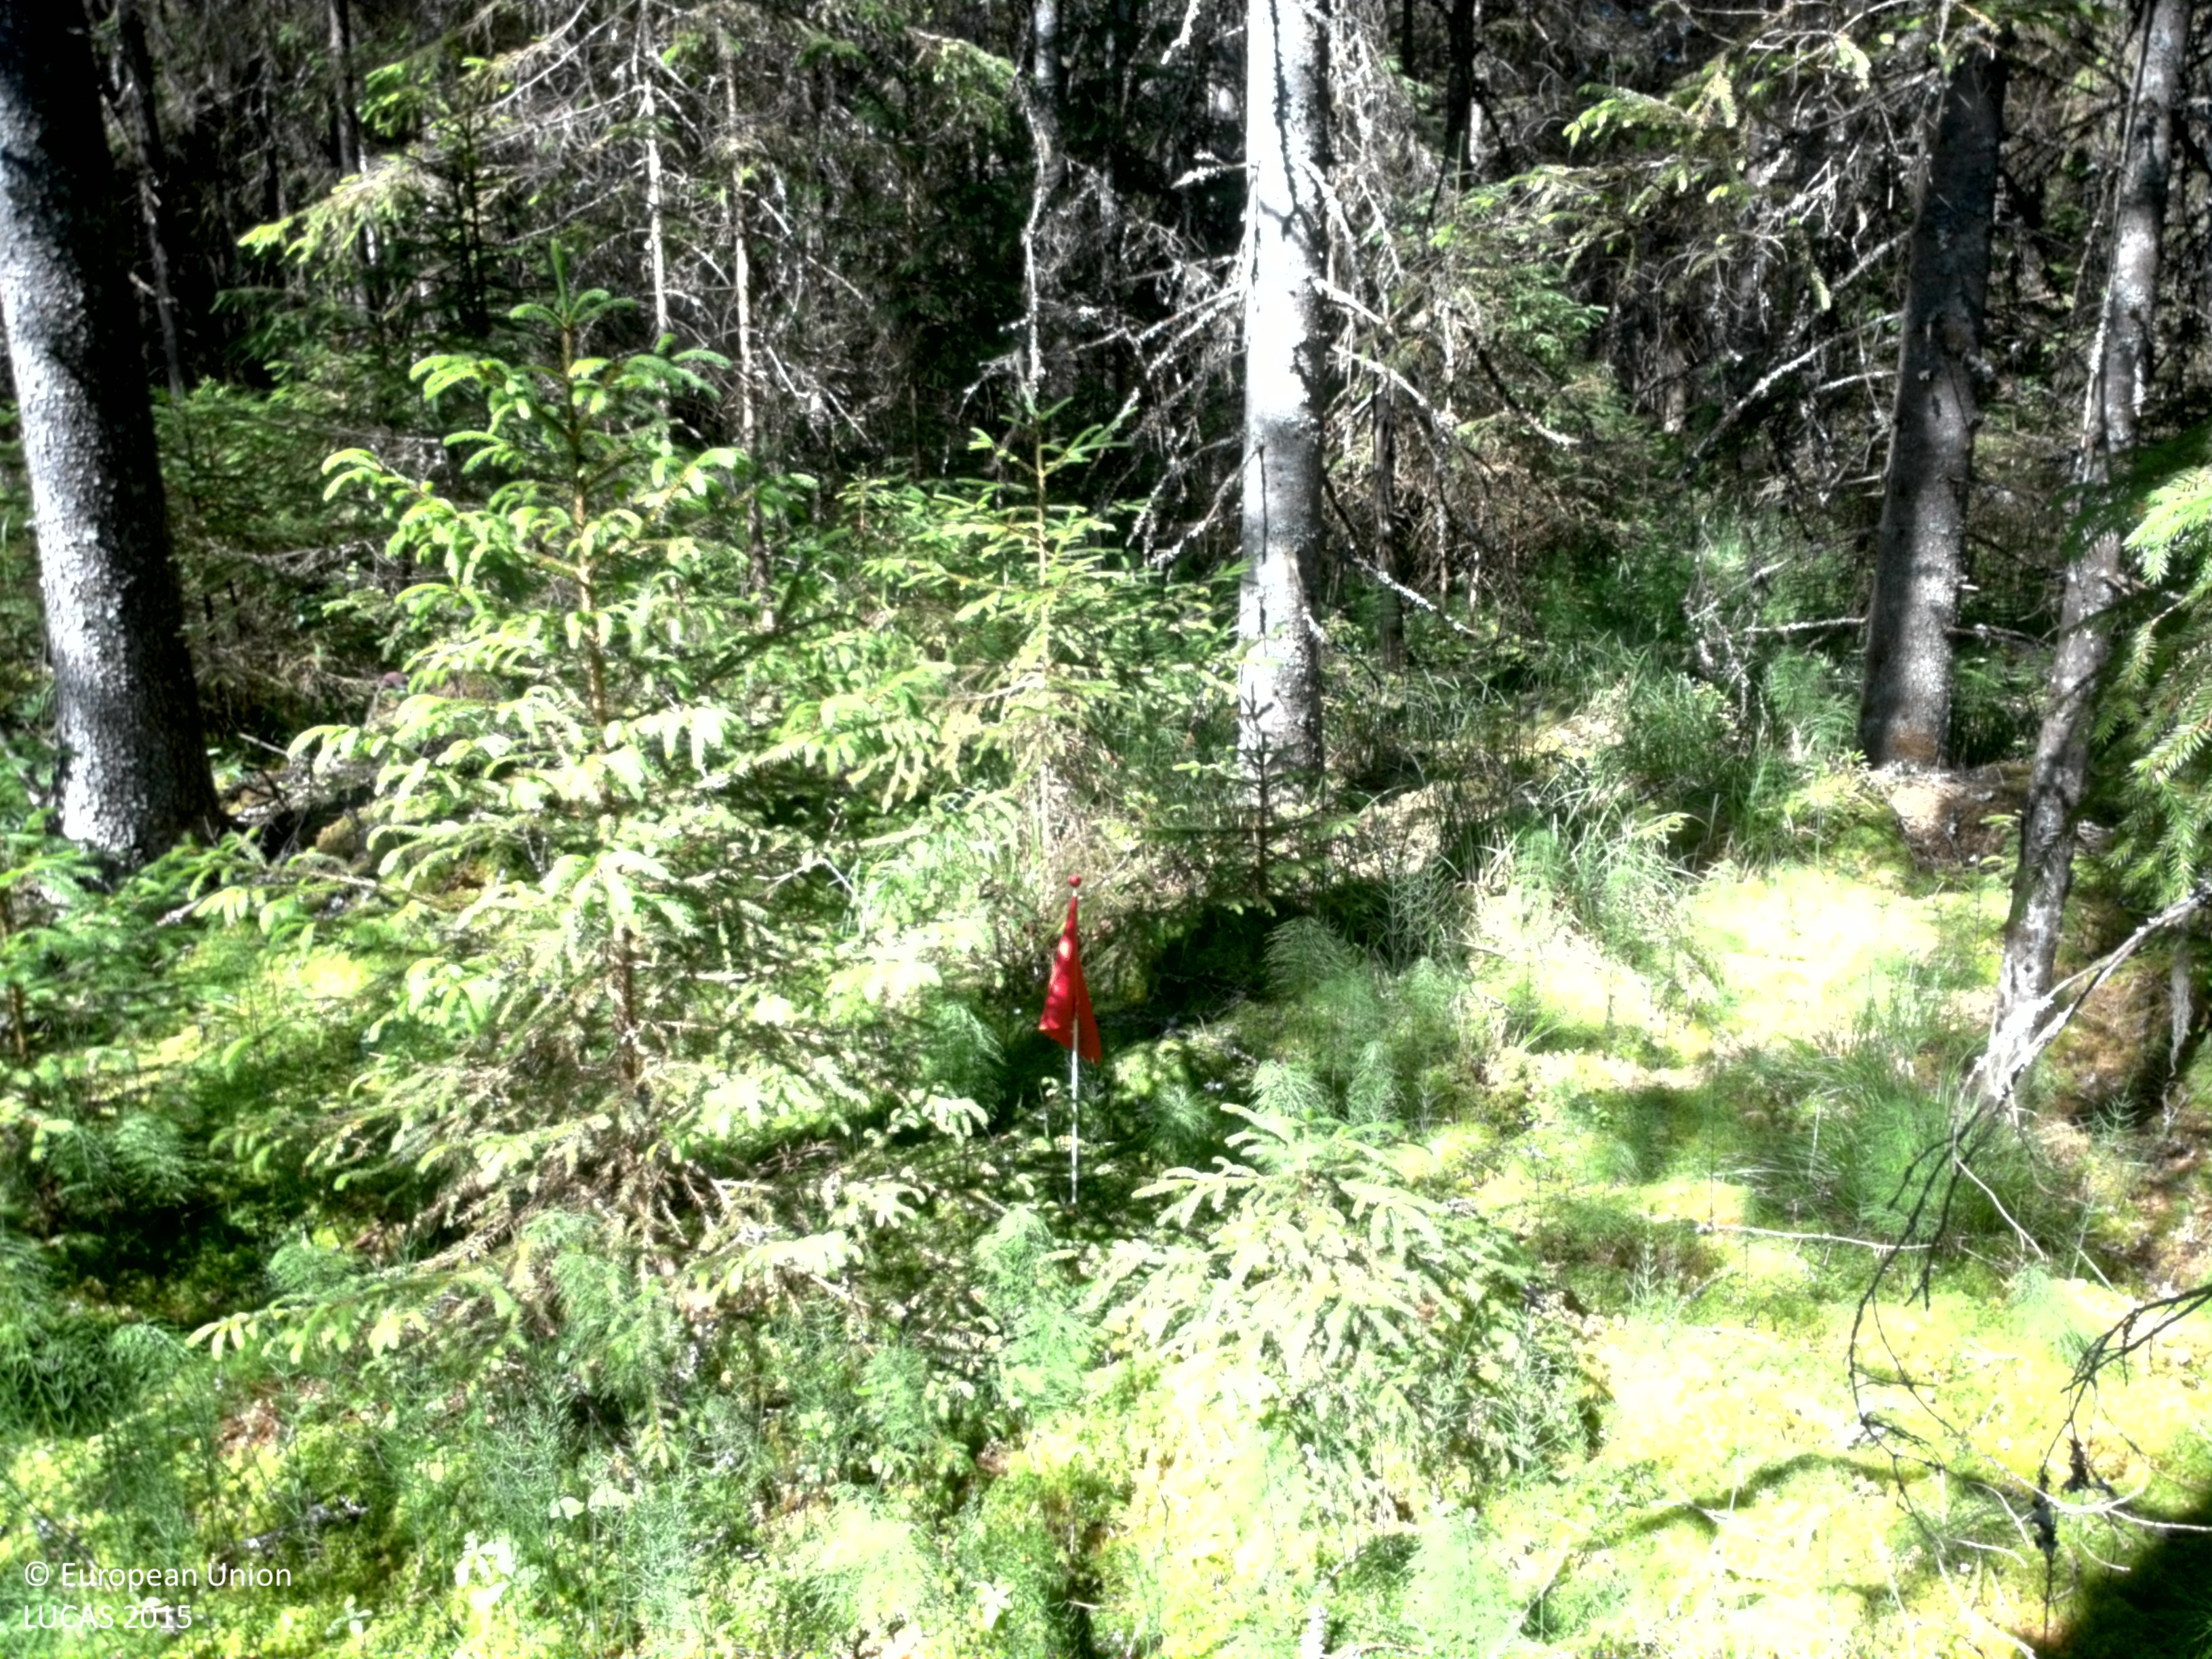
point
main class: Woodland
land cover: Spruce dominated coniferous woodland
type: boreal forest
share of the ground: 50 - 75 %
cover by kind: coniferous forest trees 55 %, shrubs 20 %, lichens and mosses 20 %, broadleaved forest trees 5 %
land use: Forestry
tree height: > 5 m
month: July
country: SE
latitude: 59.9631
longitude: 12.3395
